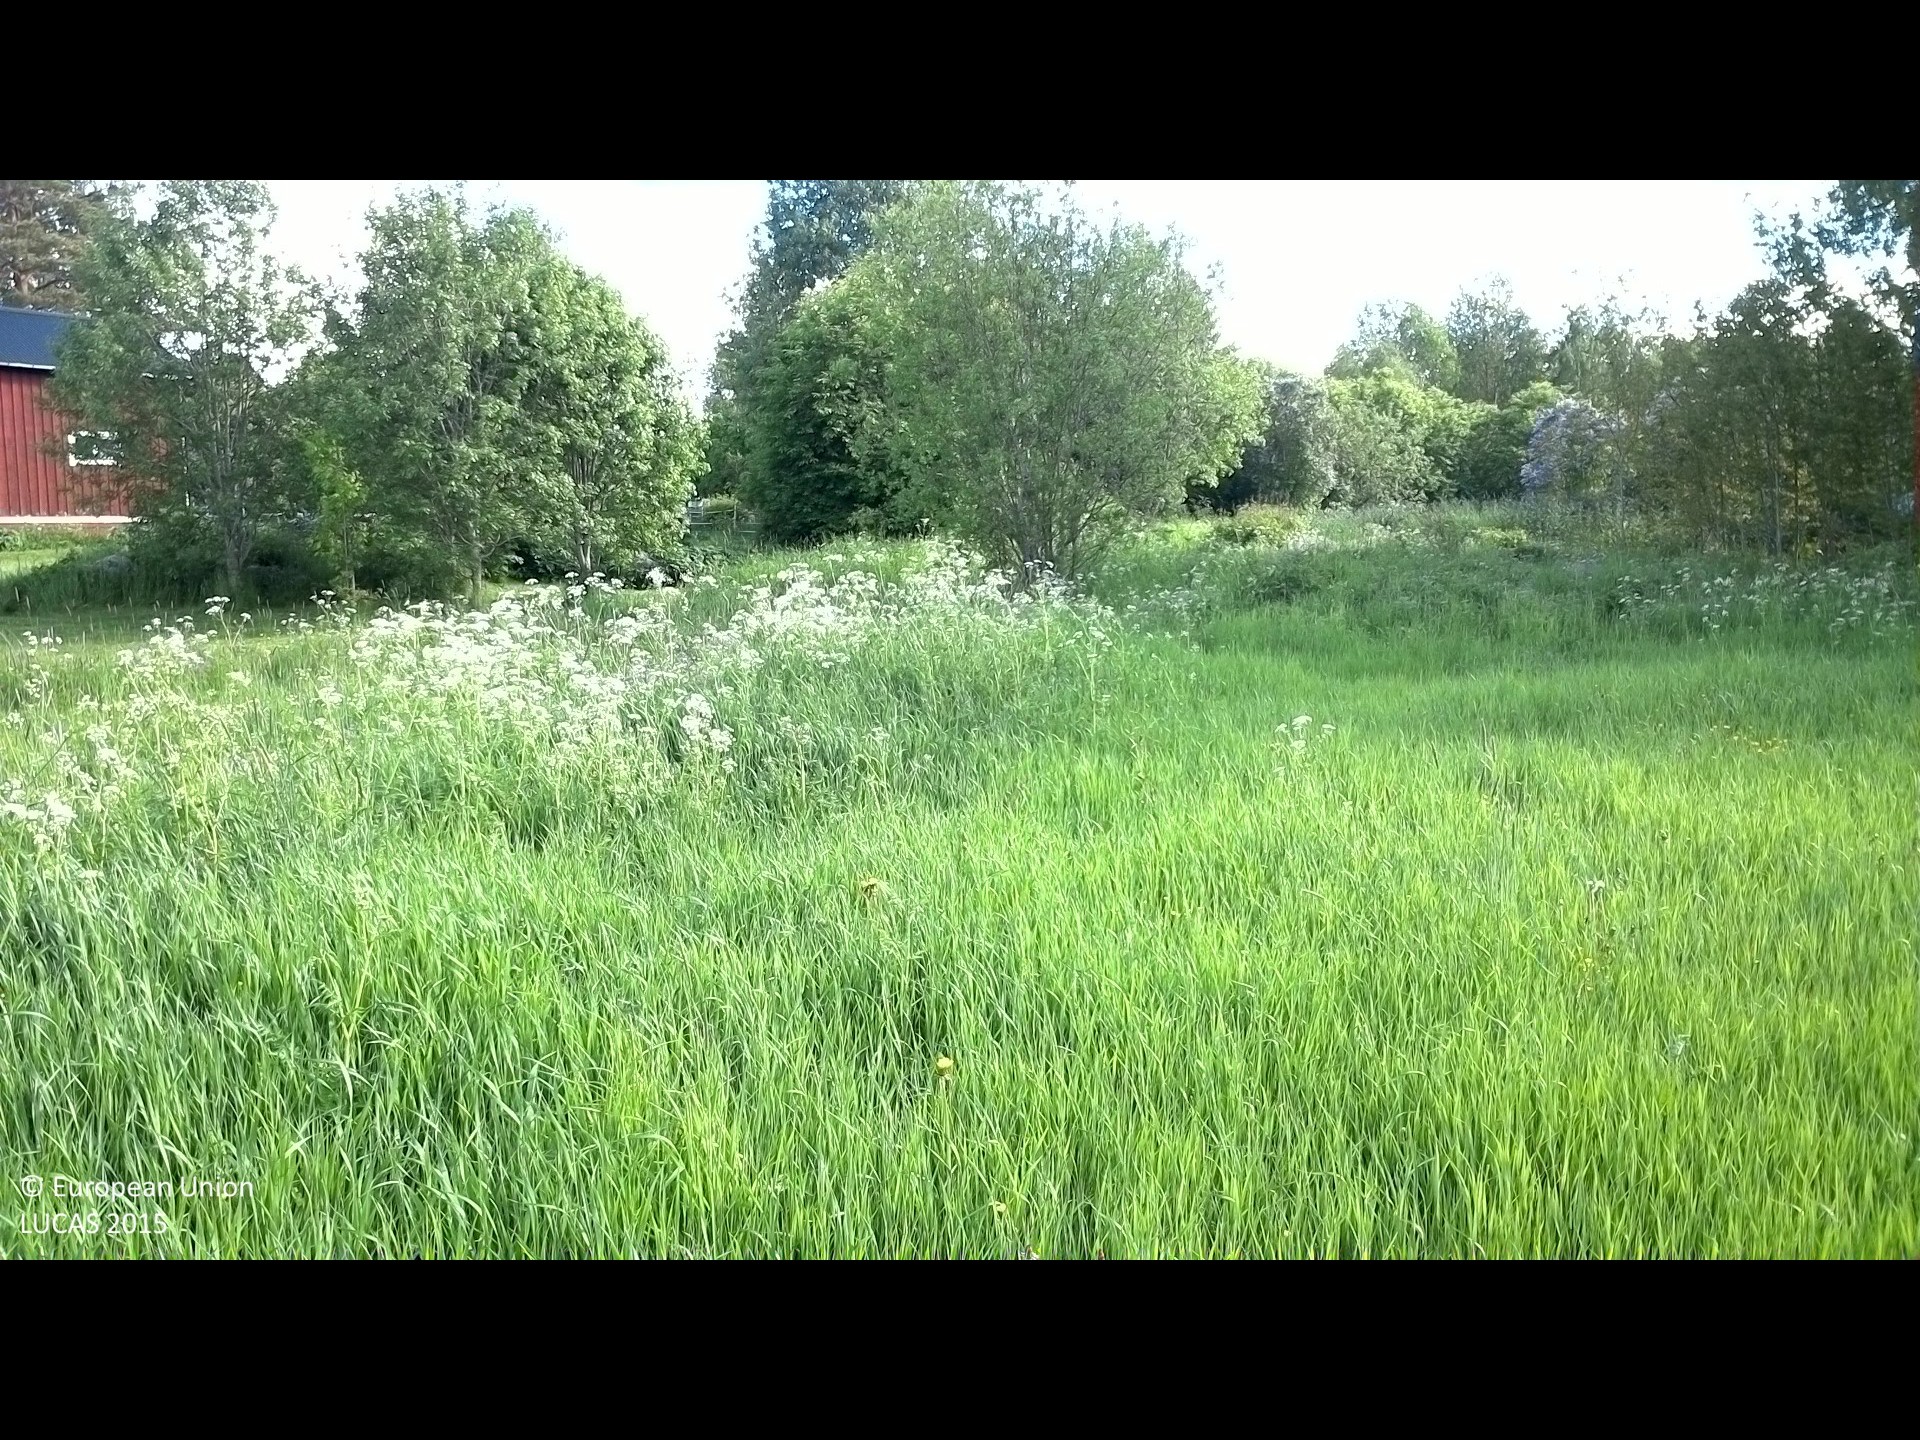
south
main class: Cropland
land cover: Other leguminous and mixtures for fodder
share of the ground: > 75 %
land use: Agriculture (excluding fallow land and kitchen gardens)
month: June
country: SE
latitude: 61.9310
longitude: 17.2413
